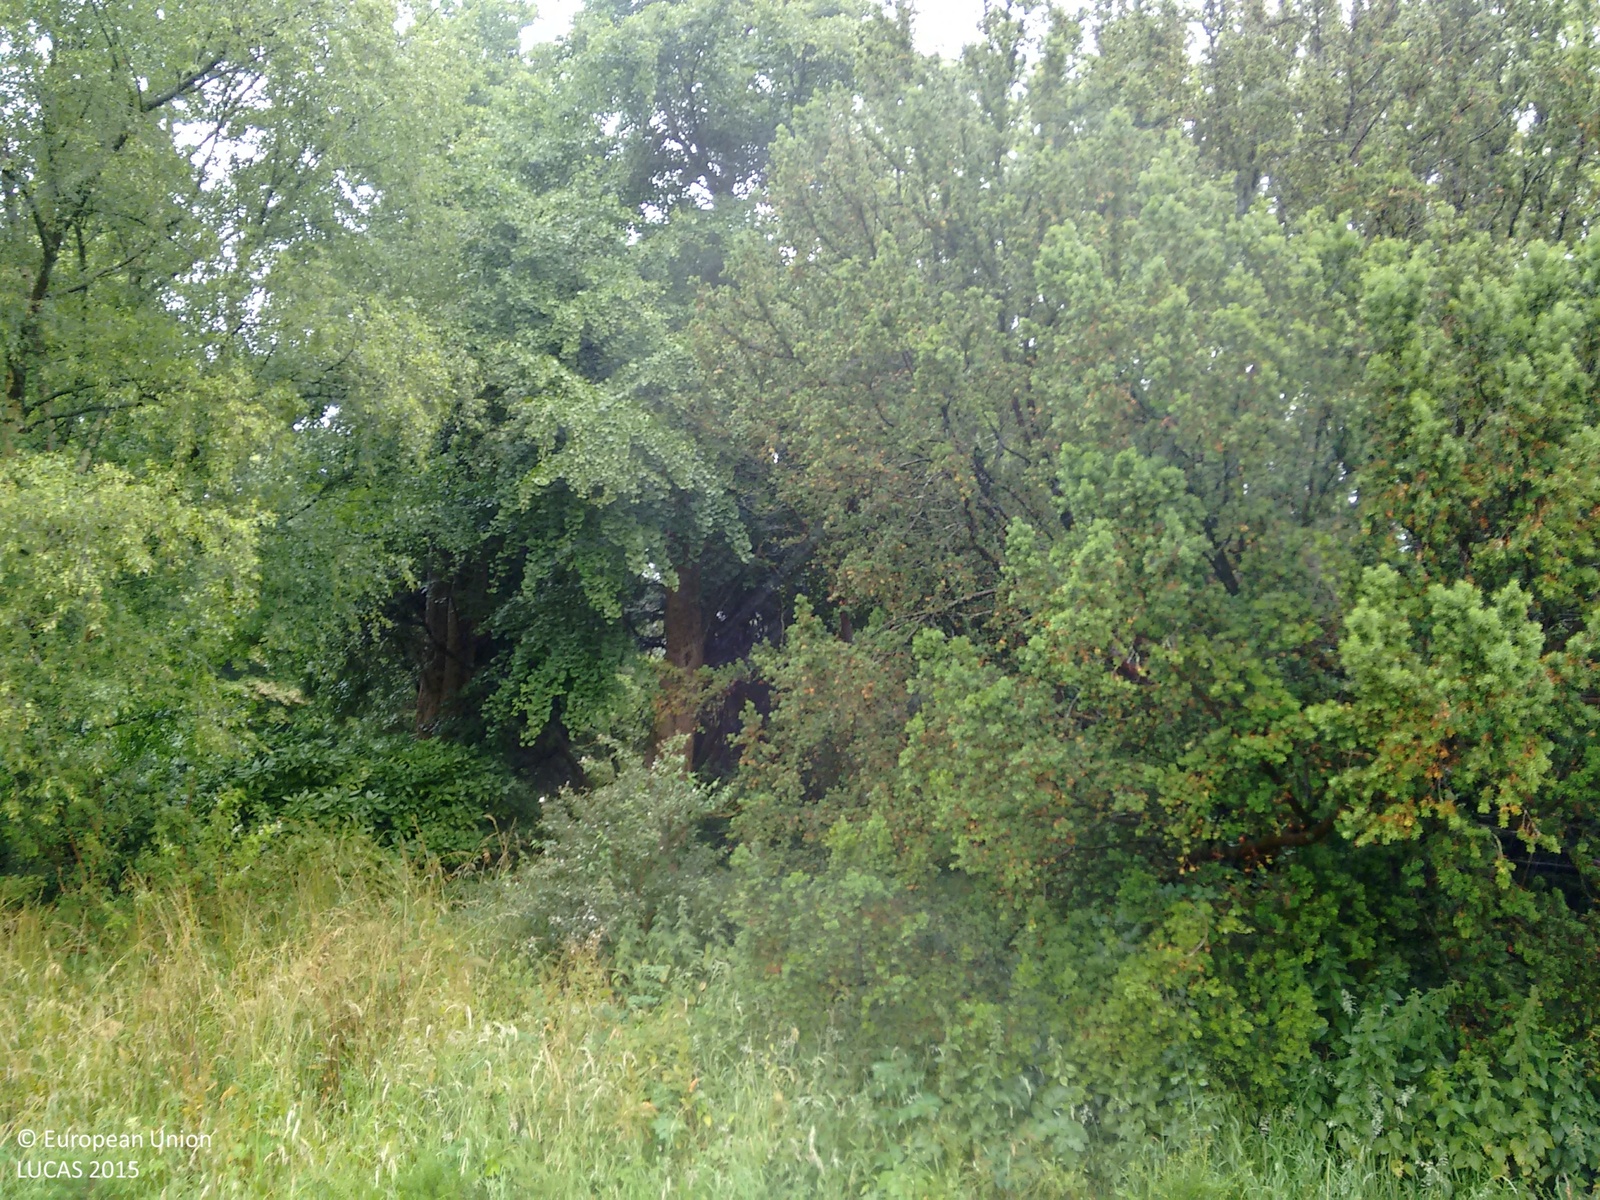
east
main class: Grassland
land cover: Grassland without tree/shrub cover
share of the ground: > 75 %
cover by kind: herbaceous plants 100 %
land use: Amenities, museums, leisure
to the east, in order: Grassland without tree/shrub cover; Tracks; Grassland without tree/shrub cover; Other mixed woodland; Tracks; Other mixed woodland; Tracks; Other mixed woodland; Tracks; Other mixed woodland; Tracks; Broadleaved woodland
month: July
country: GB
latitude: 51.4421
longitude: -3.3025
